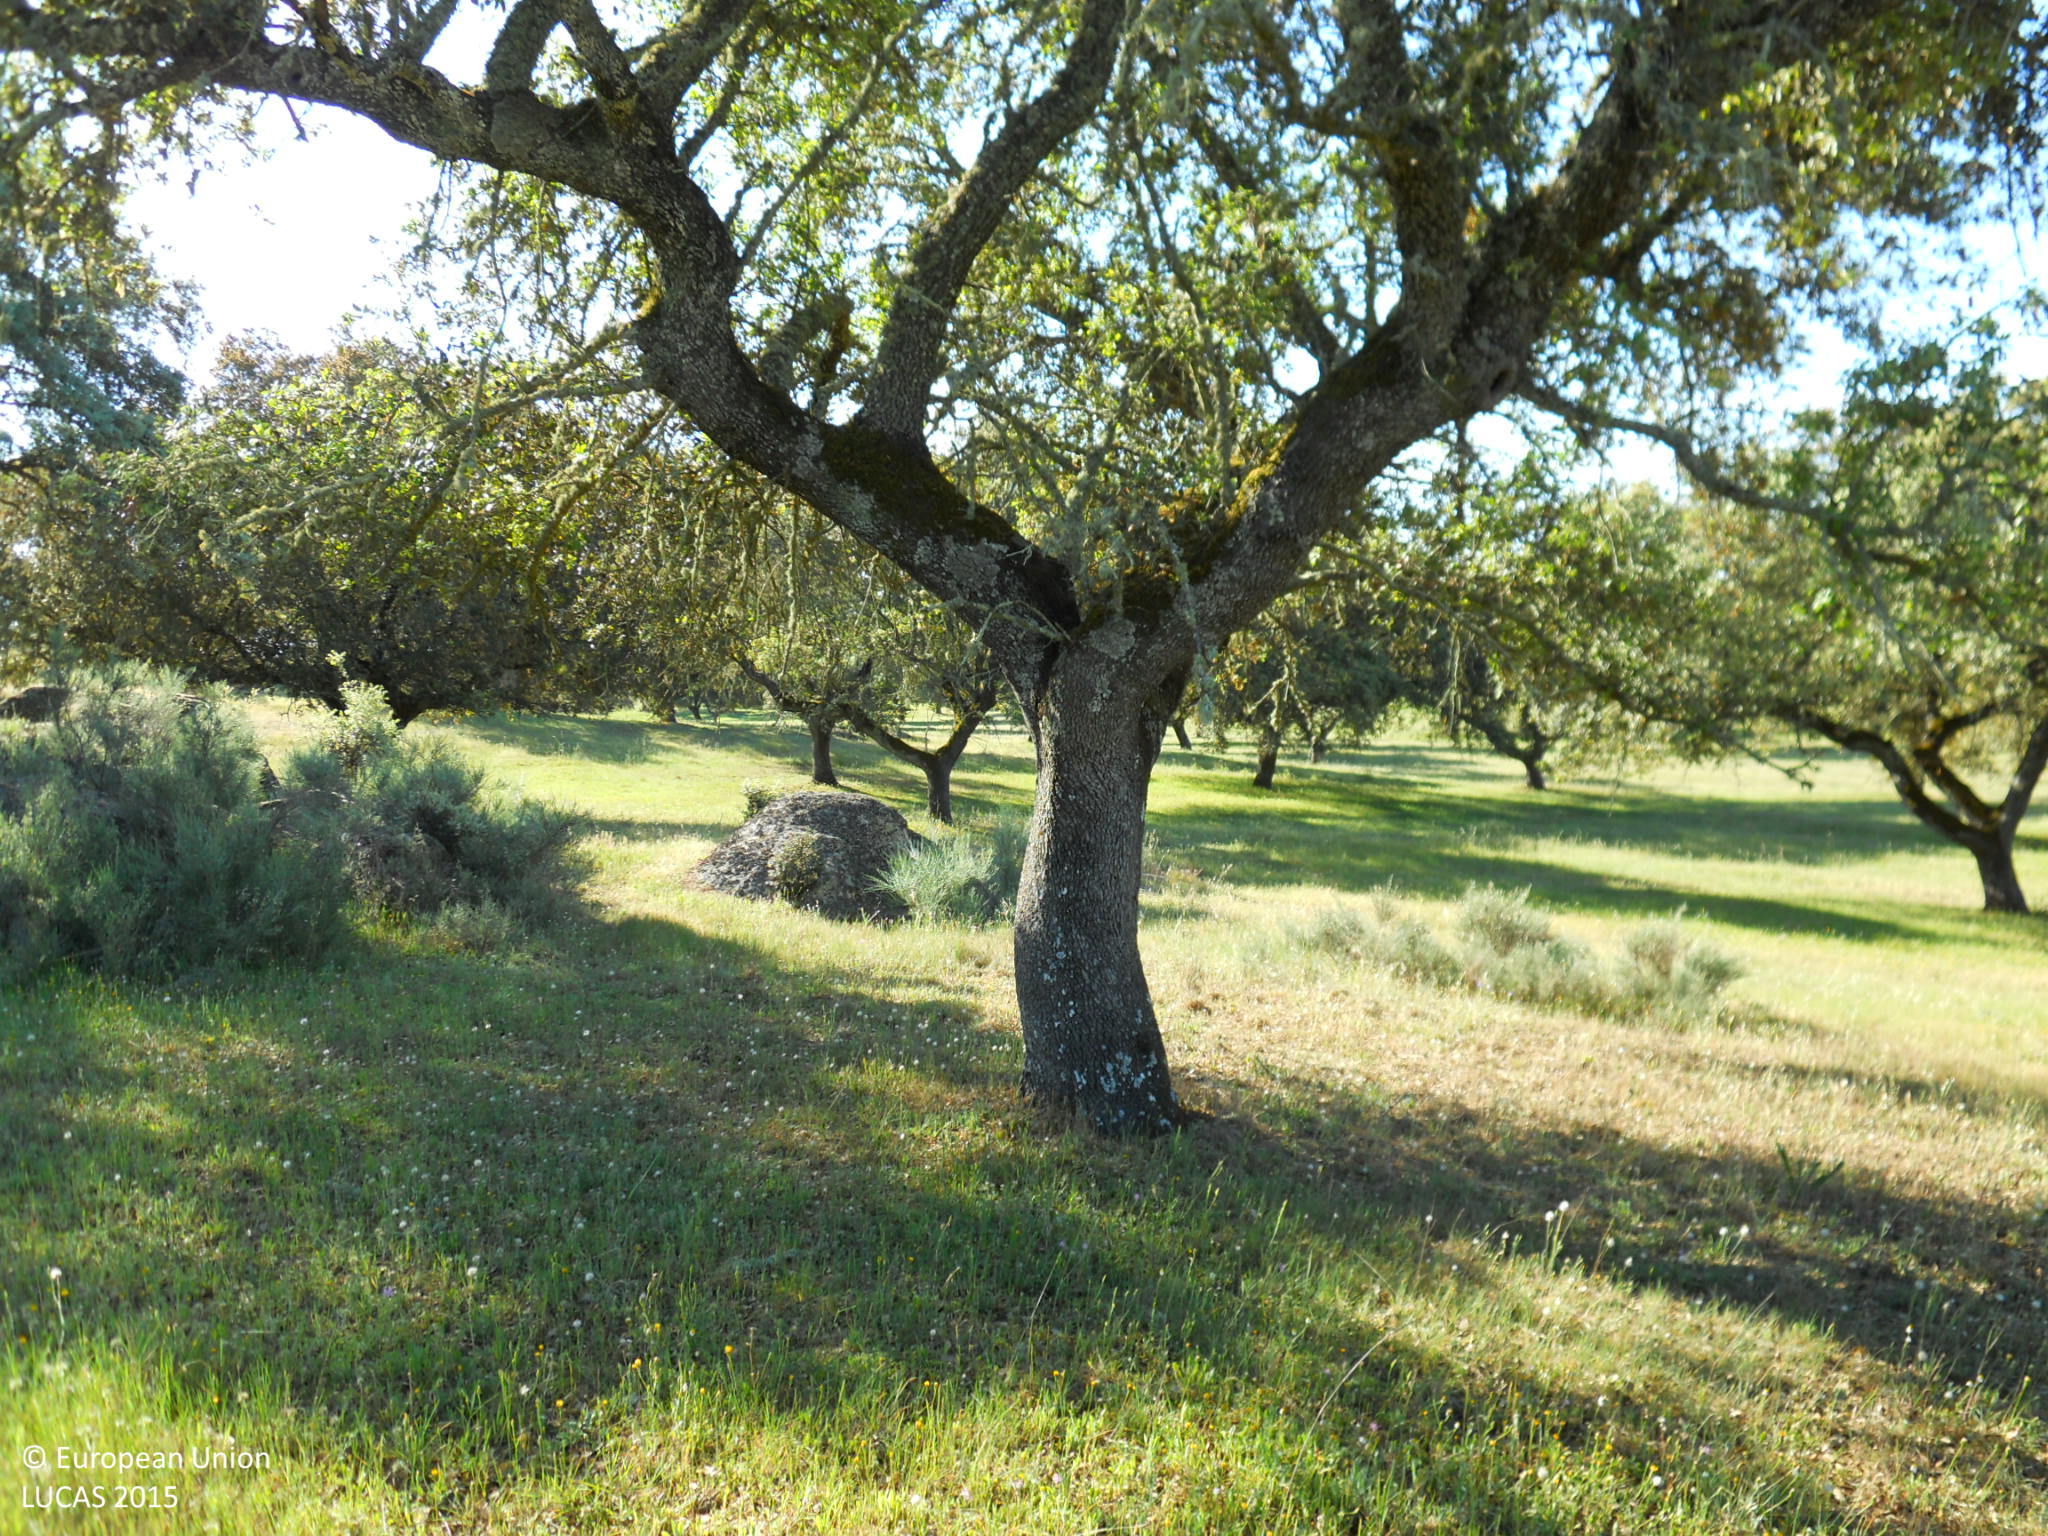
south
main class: Woodland
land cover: Broadleaved woodland
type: broadleaved evergreen forest
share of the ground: 50 - 75 %
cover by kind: broadleaved forest trees 70 %, herbaceous plants 20 %, shrubs 10 %
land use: Forestry
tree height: > 5 m
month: April
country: ES
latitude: 39.3106
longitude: -6.9754
